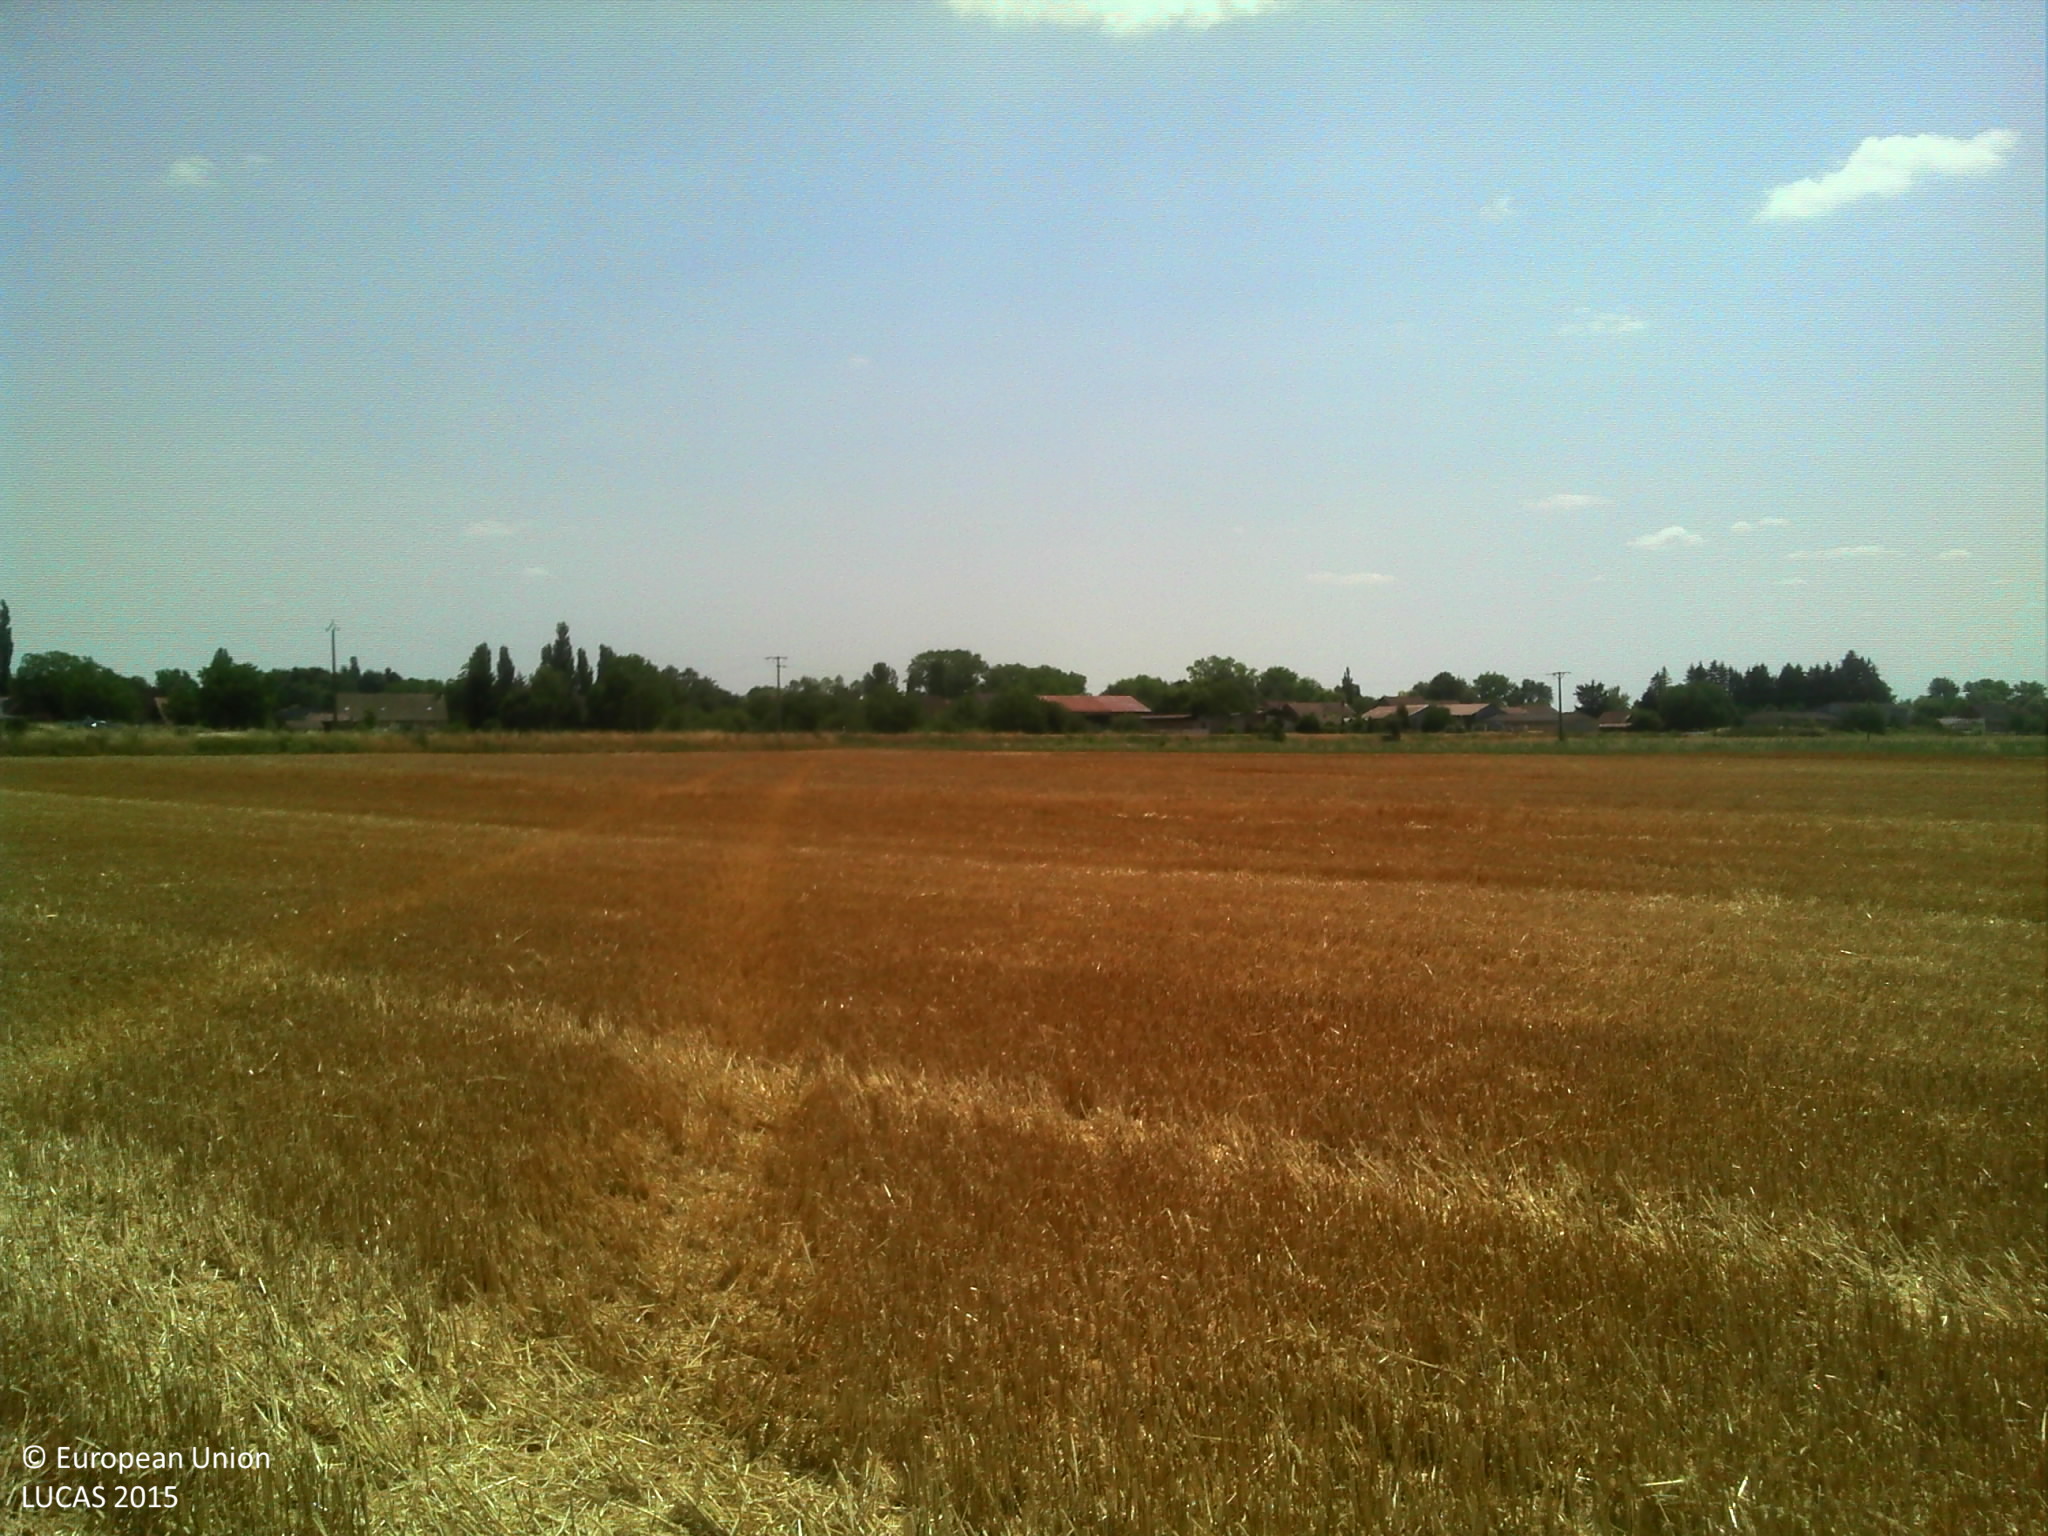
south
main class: Cropland
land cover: Common wheat
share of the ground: > 75 %
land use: Agriculture (excluding fallow land and kitchen gardens)
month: July
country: FR
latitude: 46.9055
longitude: 5.0784
